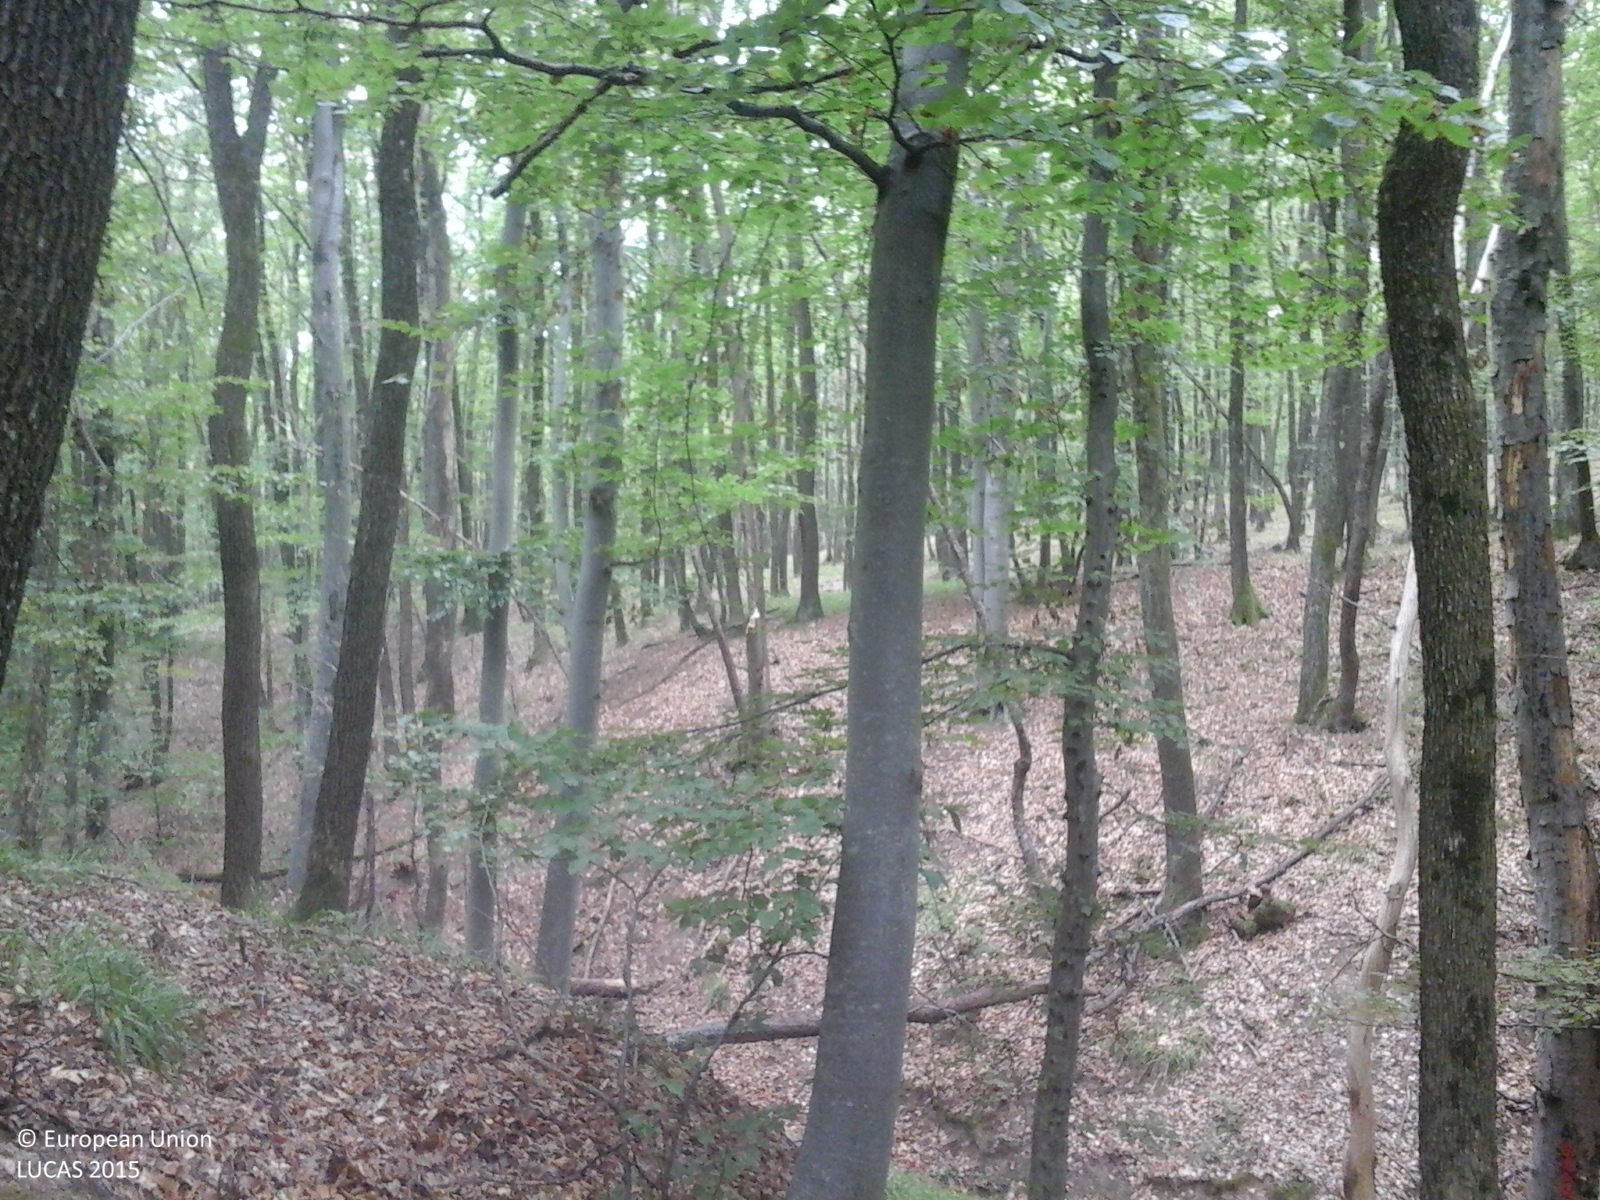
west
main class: Woodland
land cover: Broadleaved woodland
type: acidophilous oak and oak-birch forest
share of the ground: > 75 %
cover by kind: broadleaved forest trees 100 %
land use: Forestry
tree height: > 5 m
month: September
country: RO
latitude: 47.1983
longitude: 23.1201
